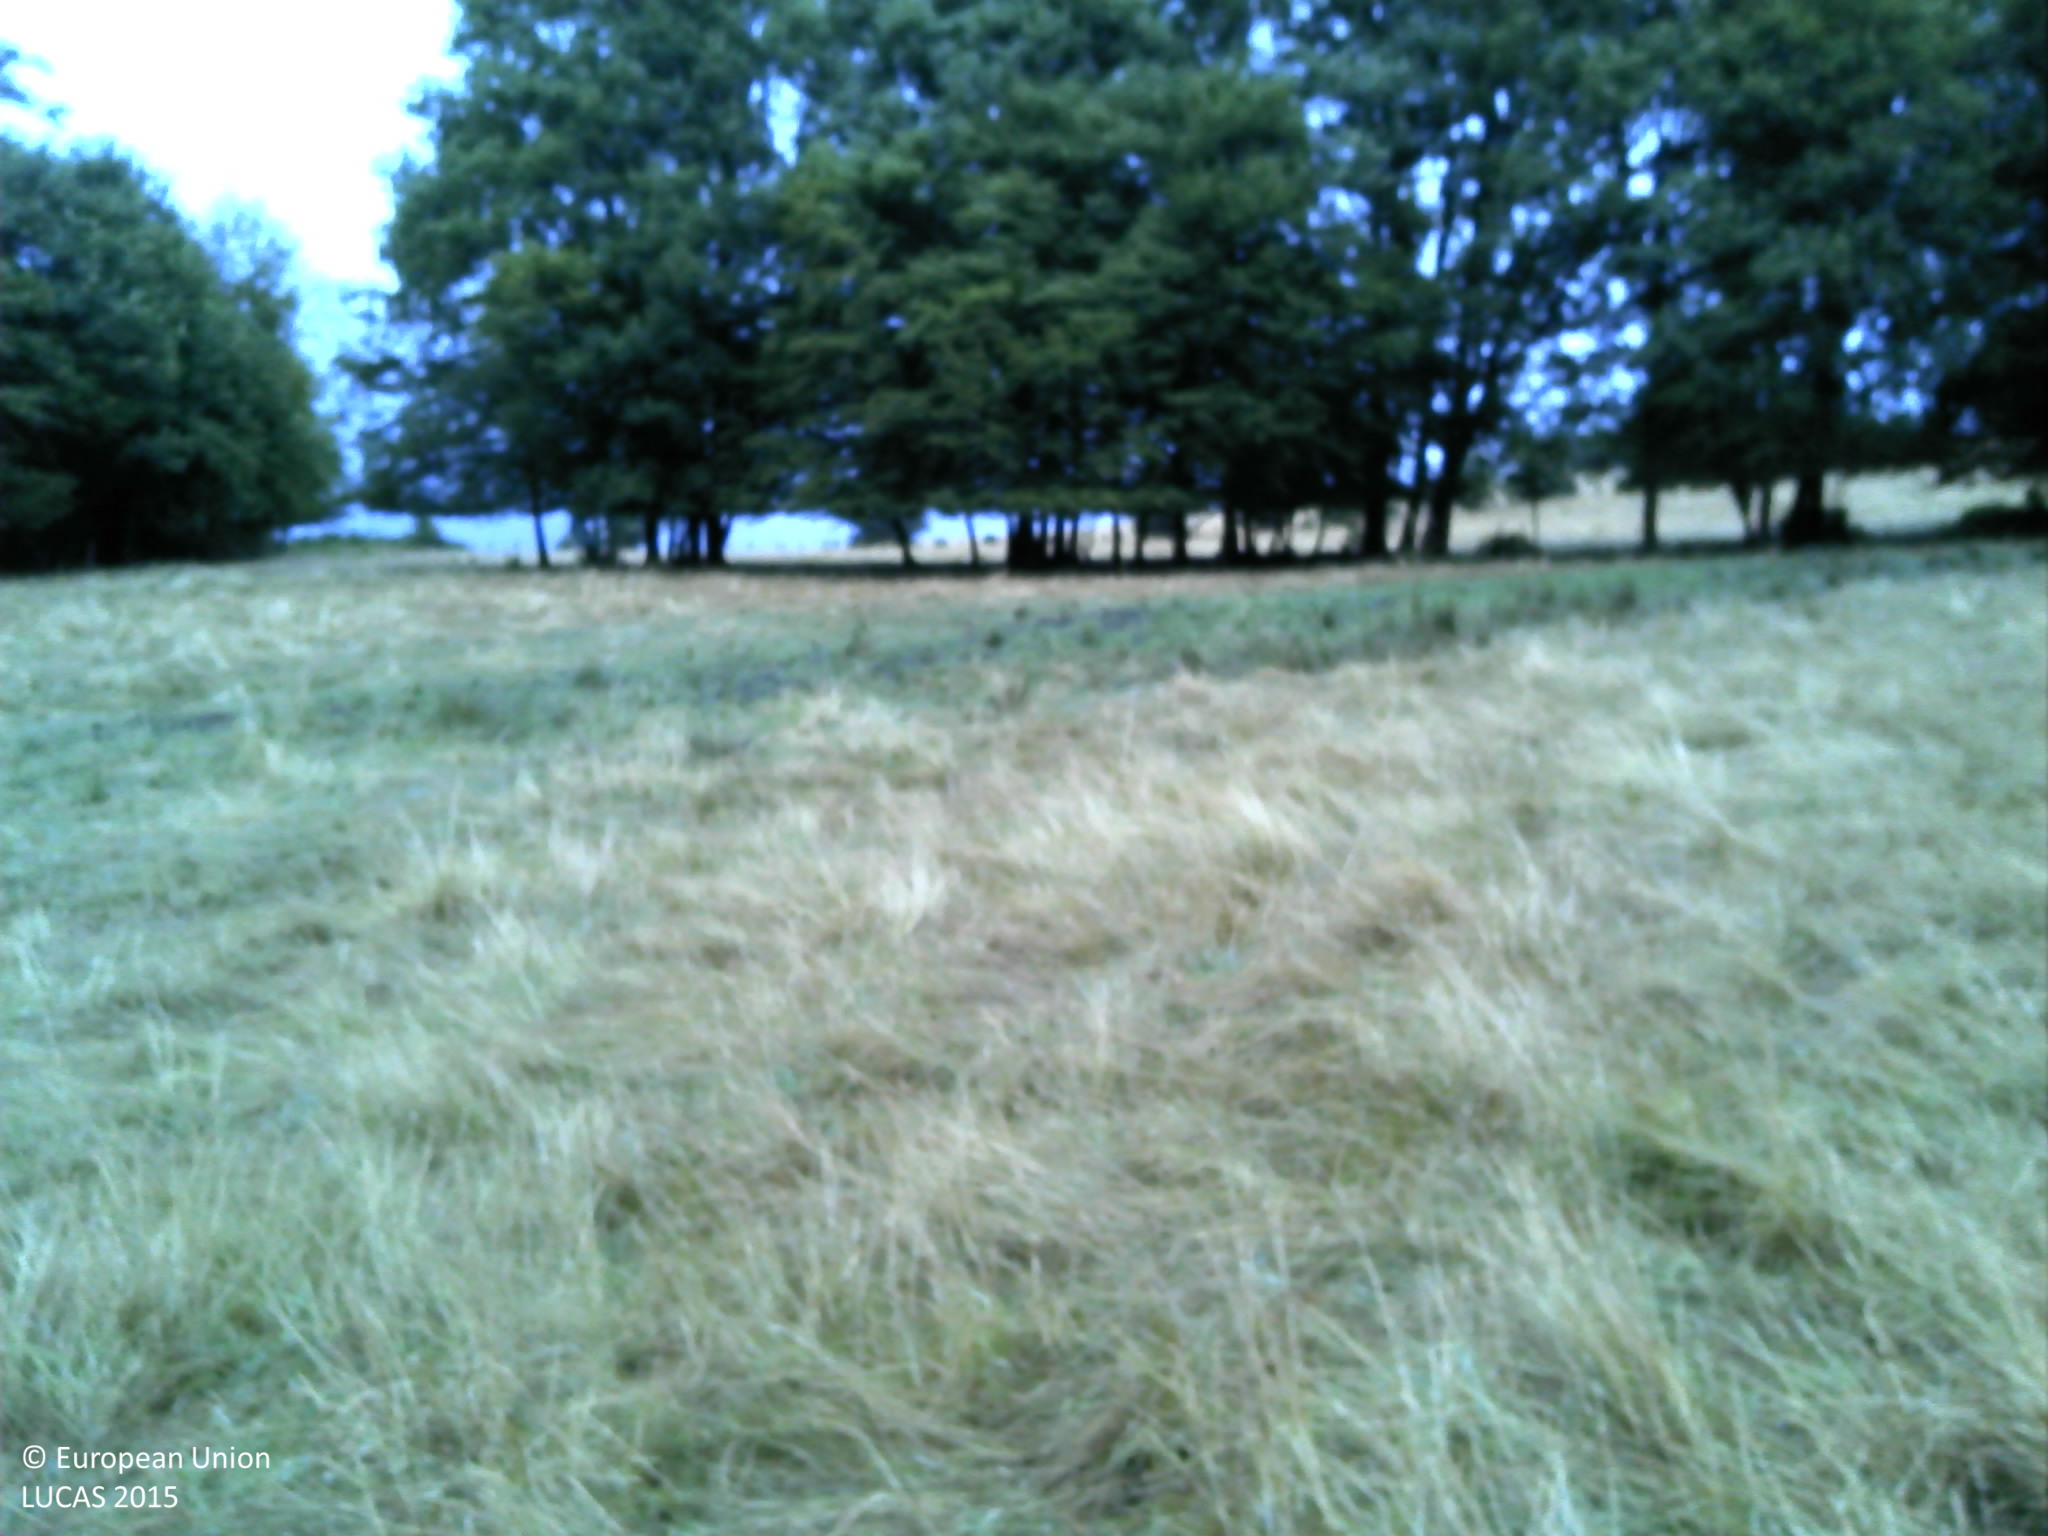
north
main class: Grassland
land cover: Grassland with sparse tree/shrub cover
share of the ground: > 75 %
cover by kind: herbaceous plants 95 %, broadleaved forest trees 5 %
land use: Agriculture (excluding fallow land and kitchen gardens)
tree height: > 5 m
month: July
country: FR
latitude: 47.9990
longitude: 6.2884
